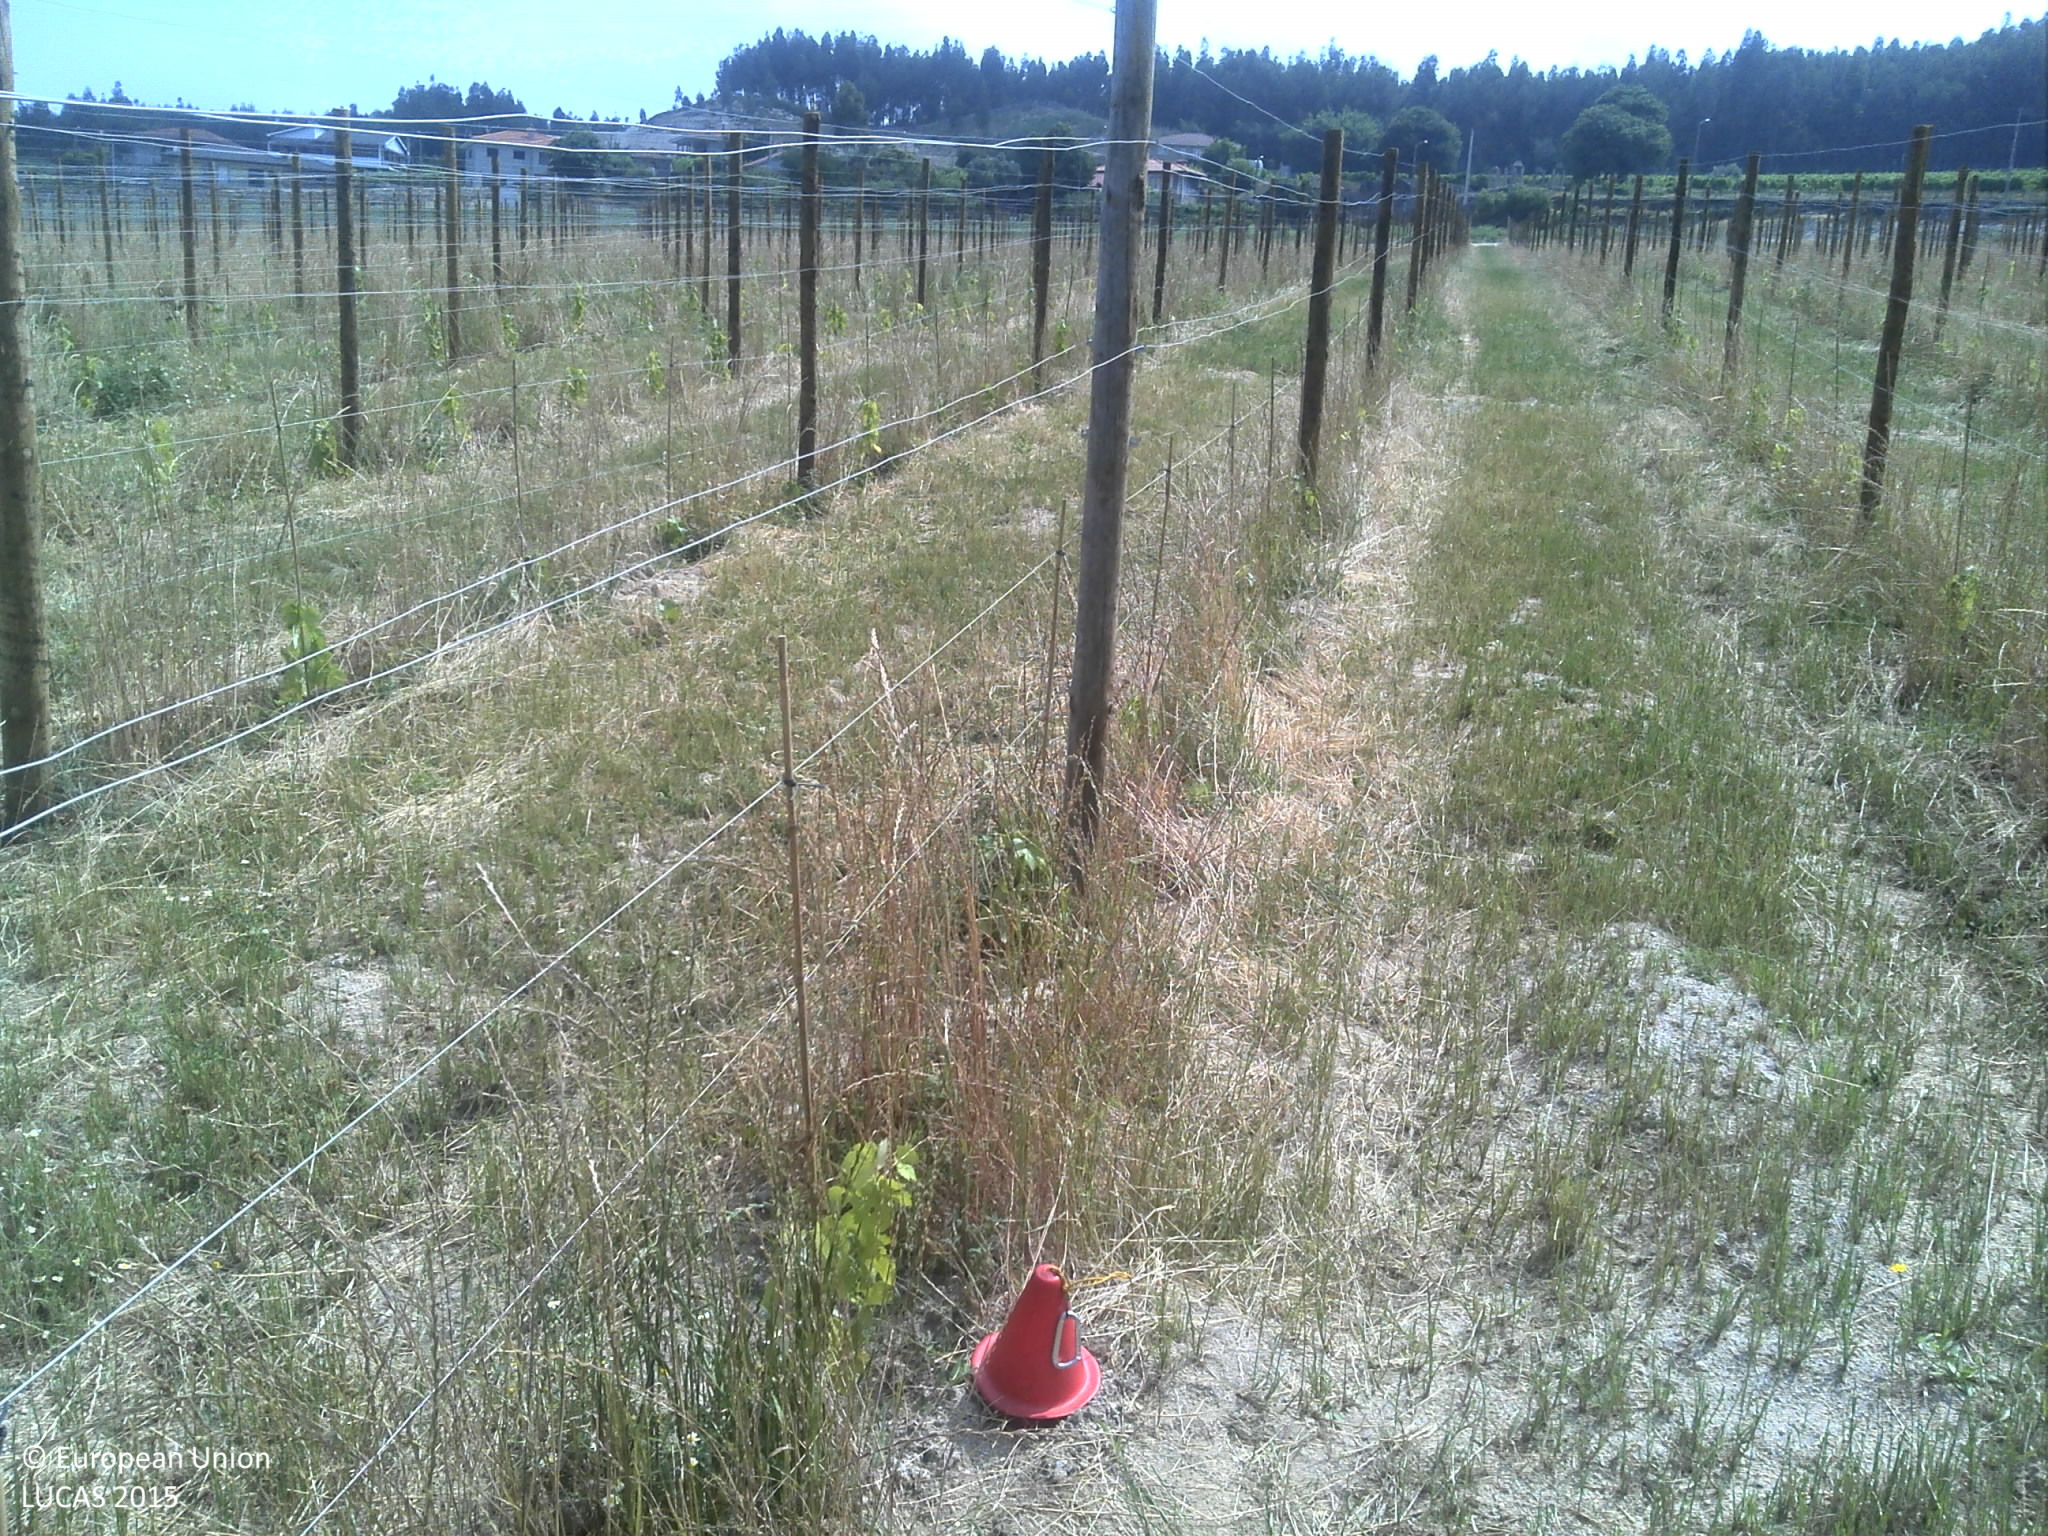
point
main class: Cropland
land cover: Vineyards
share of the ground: < 10 %
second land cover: Grassland without tree/shrub cover
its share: 50 - 75 %
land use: Agriculture (excluding fallow land and kitchen gardens)
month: June
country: PT
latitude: 41.1470
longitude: -8.1425
